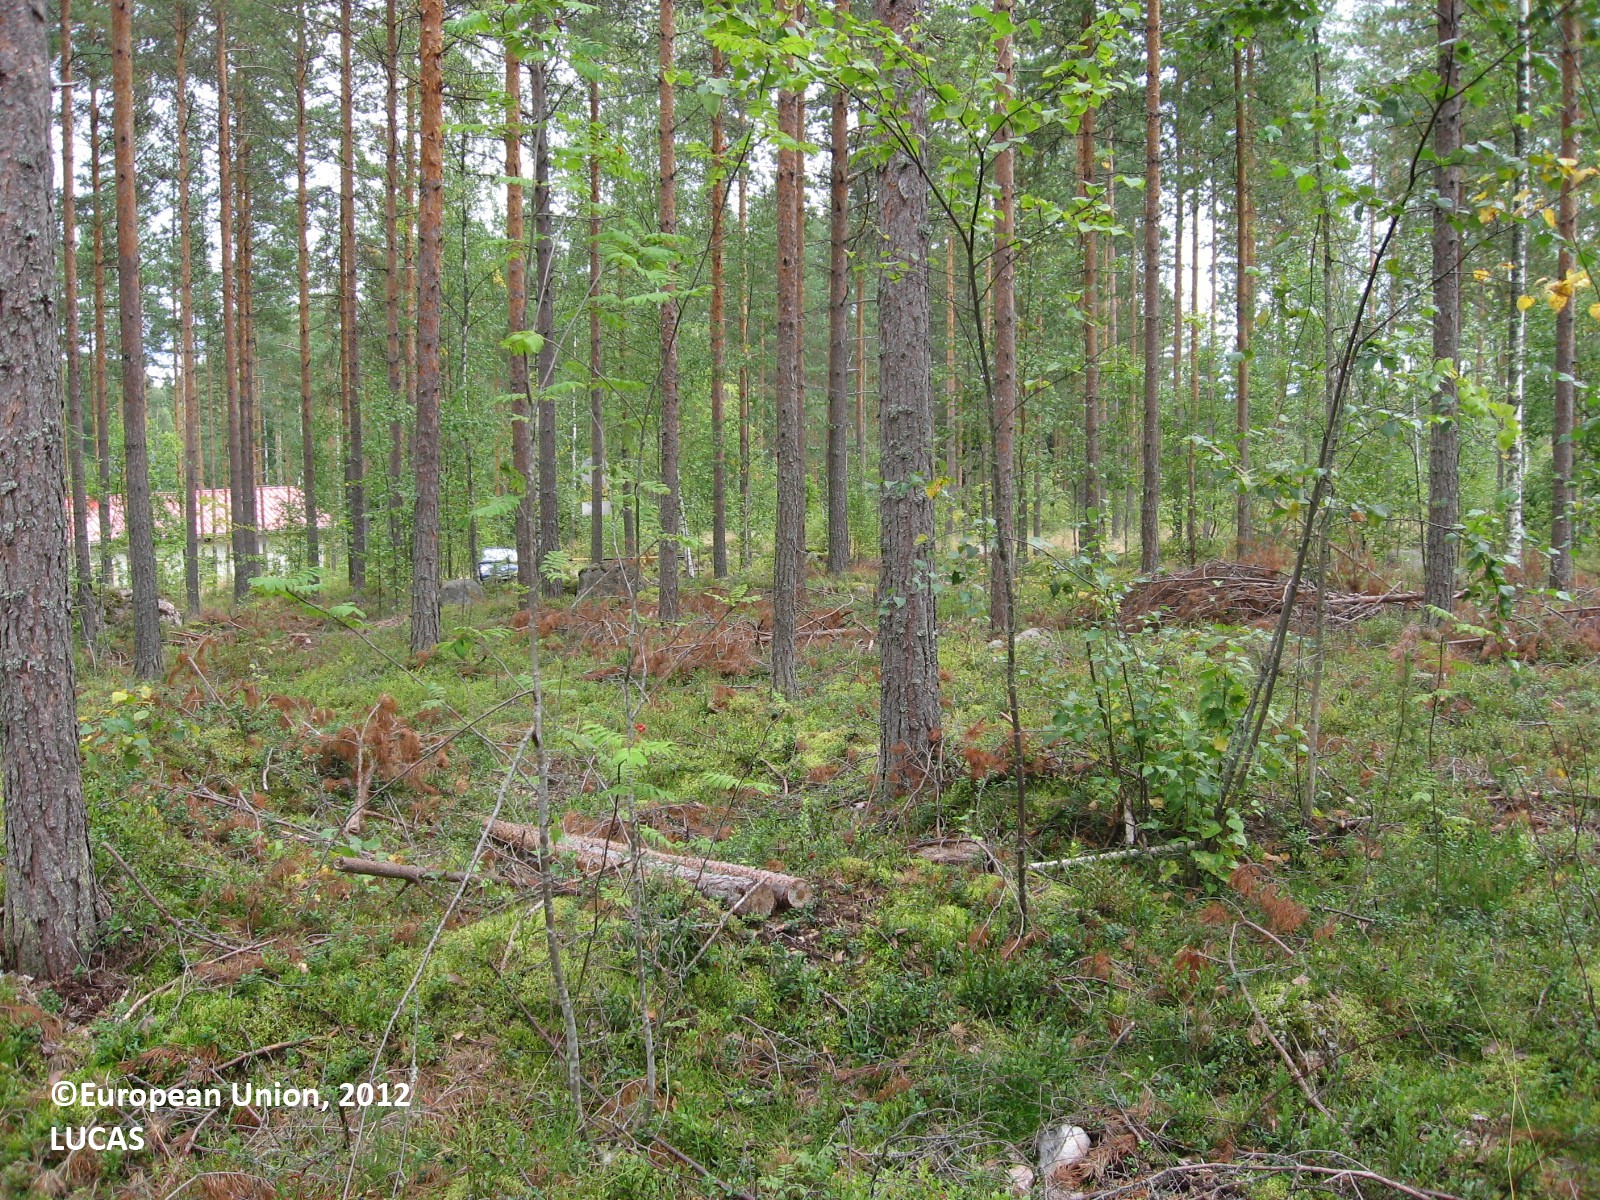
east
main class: Woodland
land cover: Pine dominated mixed woodland
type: boreal forest
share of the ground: 50 - 75 %
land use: Forestry
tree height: > 5 m
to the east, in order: Pine dominated mixed woodland; Paved roads, cycling and walking lanes; Grass margins; Pine dominated mixed woodland; Artificial constructions in urban areas; Broadleaved woodland; Paved roads, cycling and walking lanes; Spruce dominated mixed woodland; Arable land (only in case pi)
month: September
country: FI
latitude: 61.1268
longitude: 26.4302
